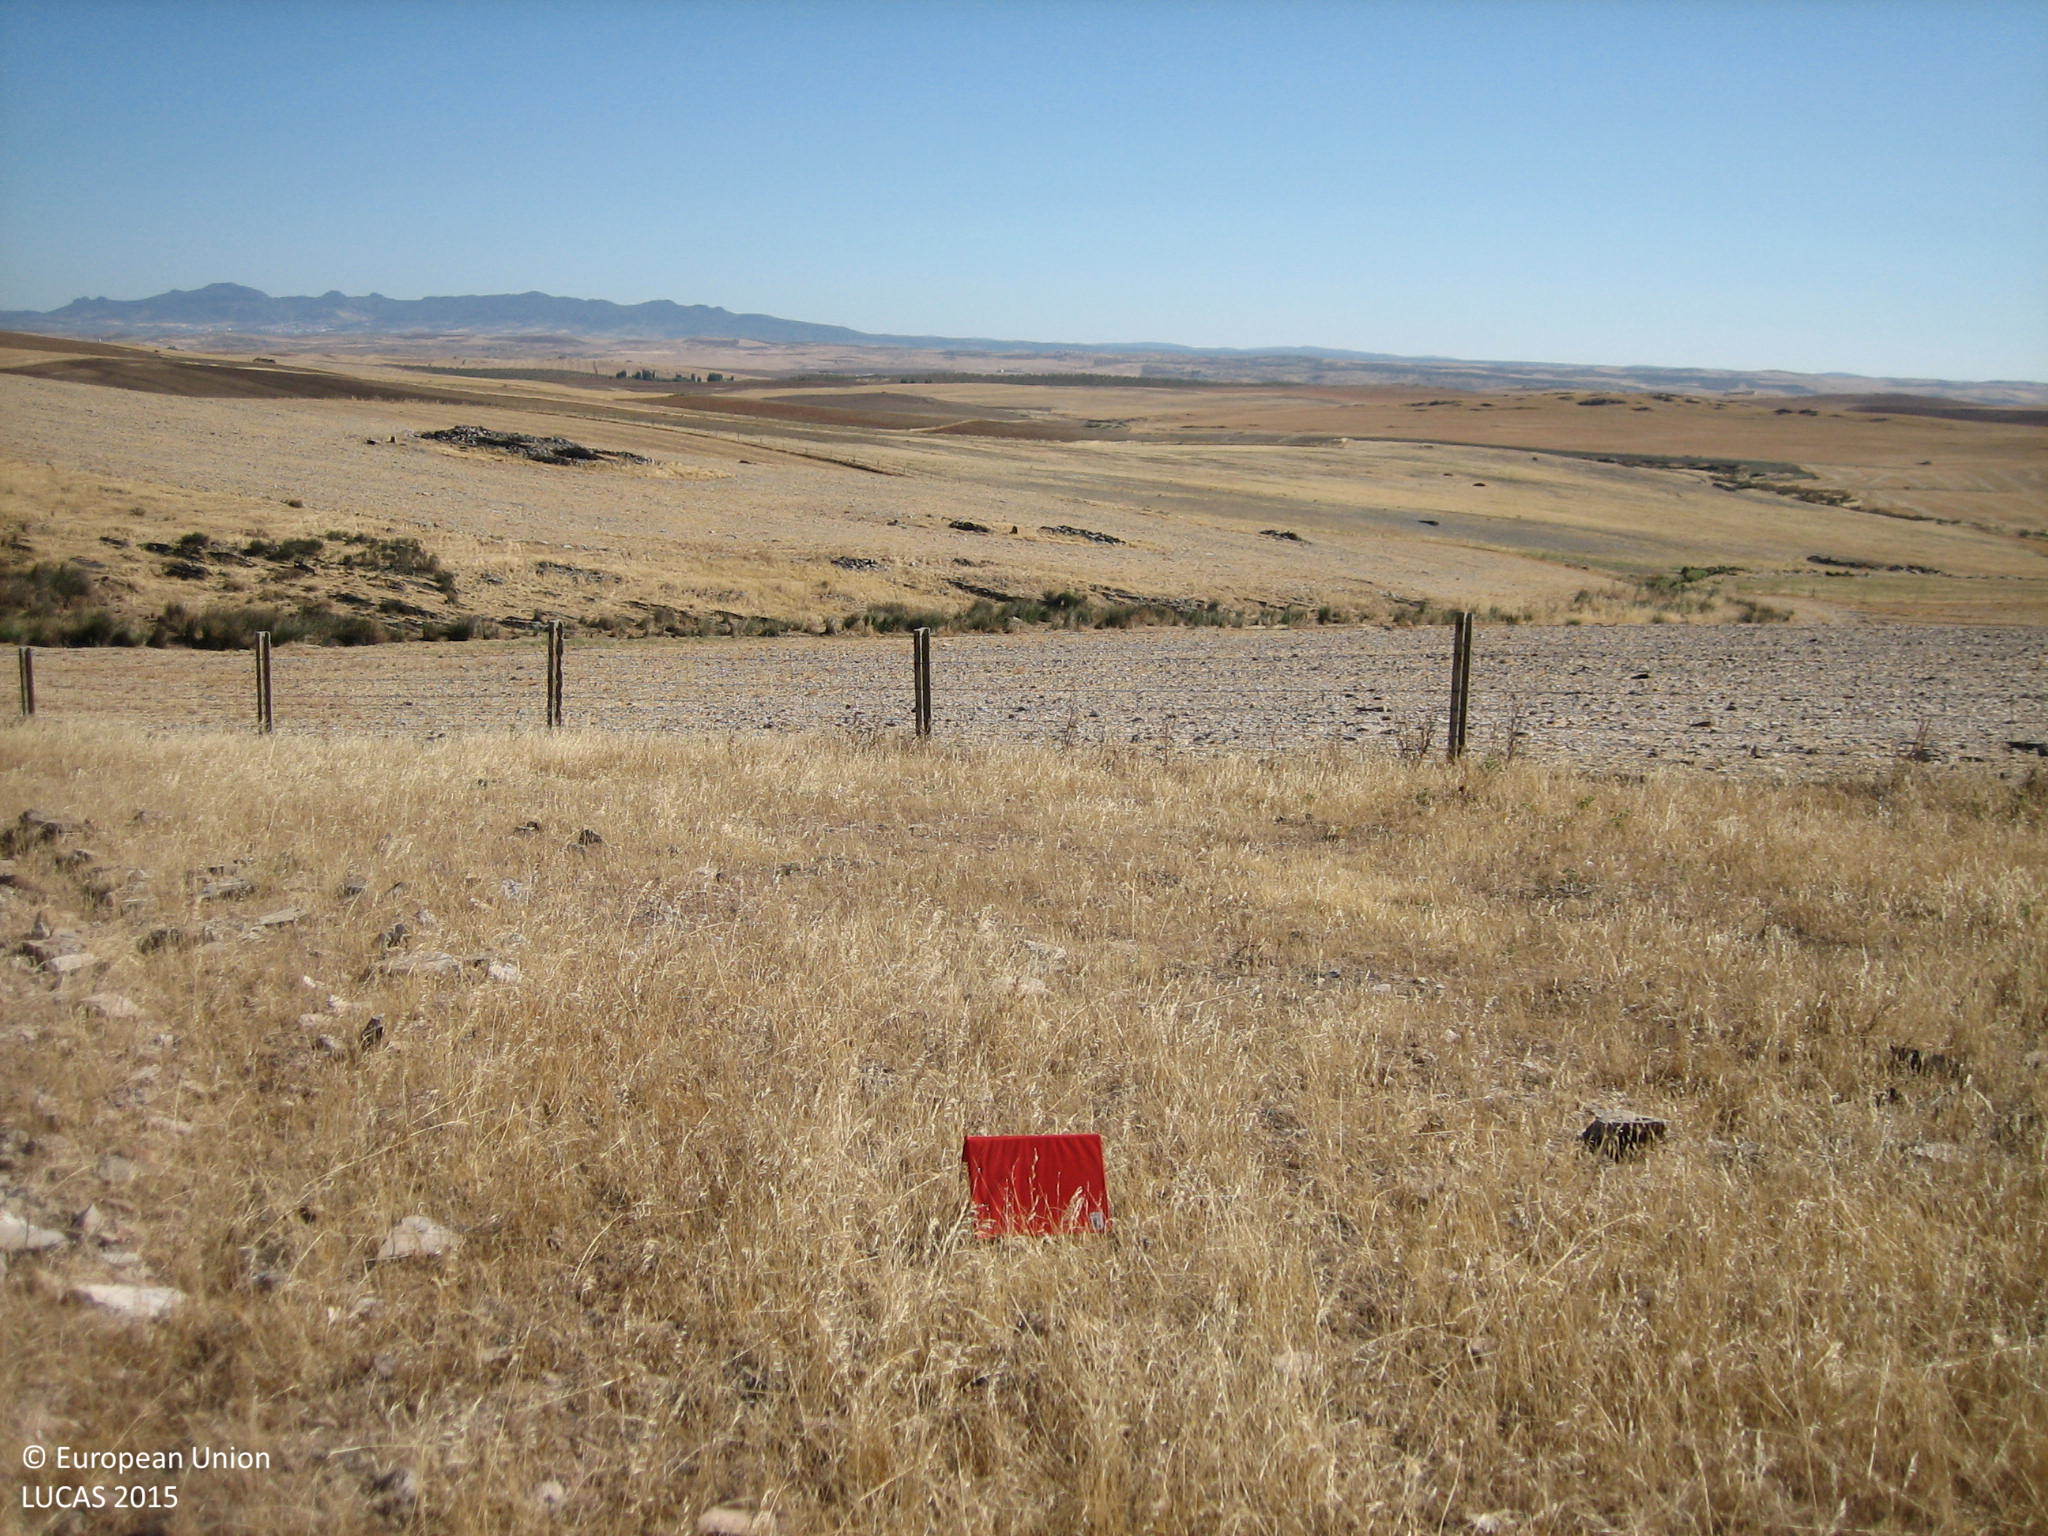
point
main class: Grassland
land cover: Spontaneously vegetated surfaces
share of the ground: > 75 %
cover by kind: herbaceous plants 100 %
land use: Fallow land
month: July
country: ES
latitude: 38.3710
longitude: -6.1256
